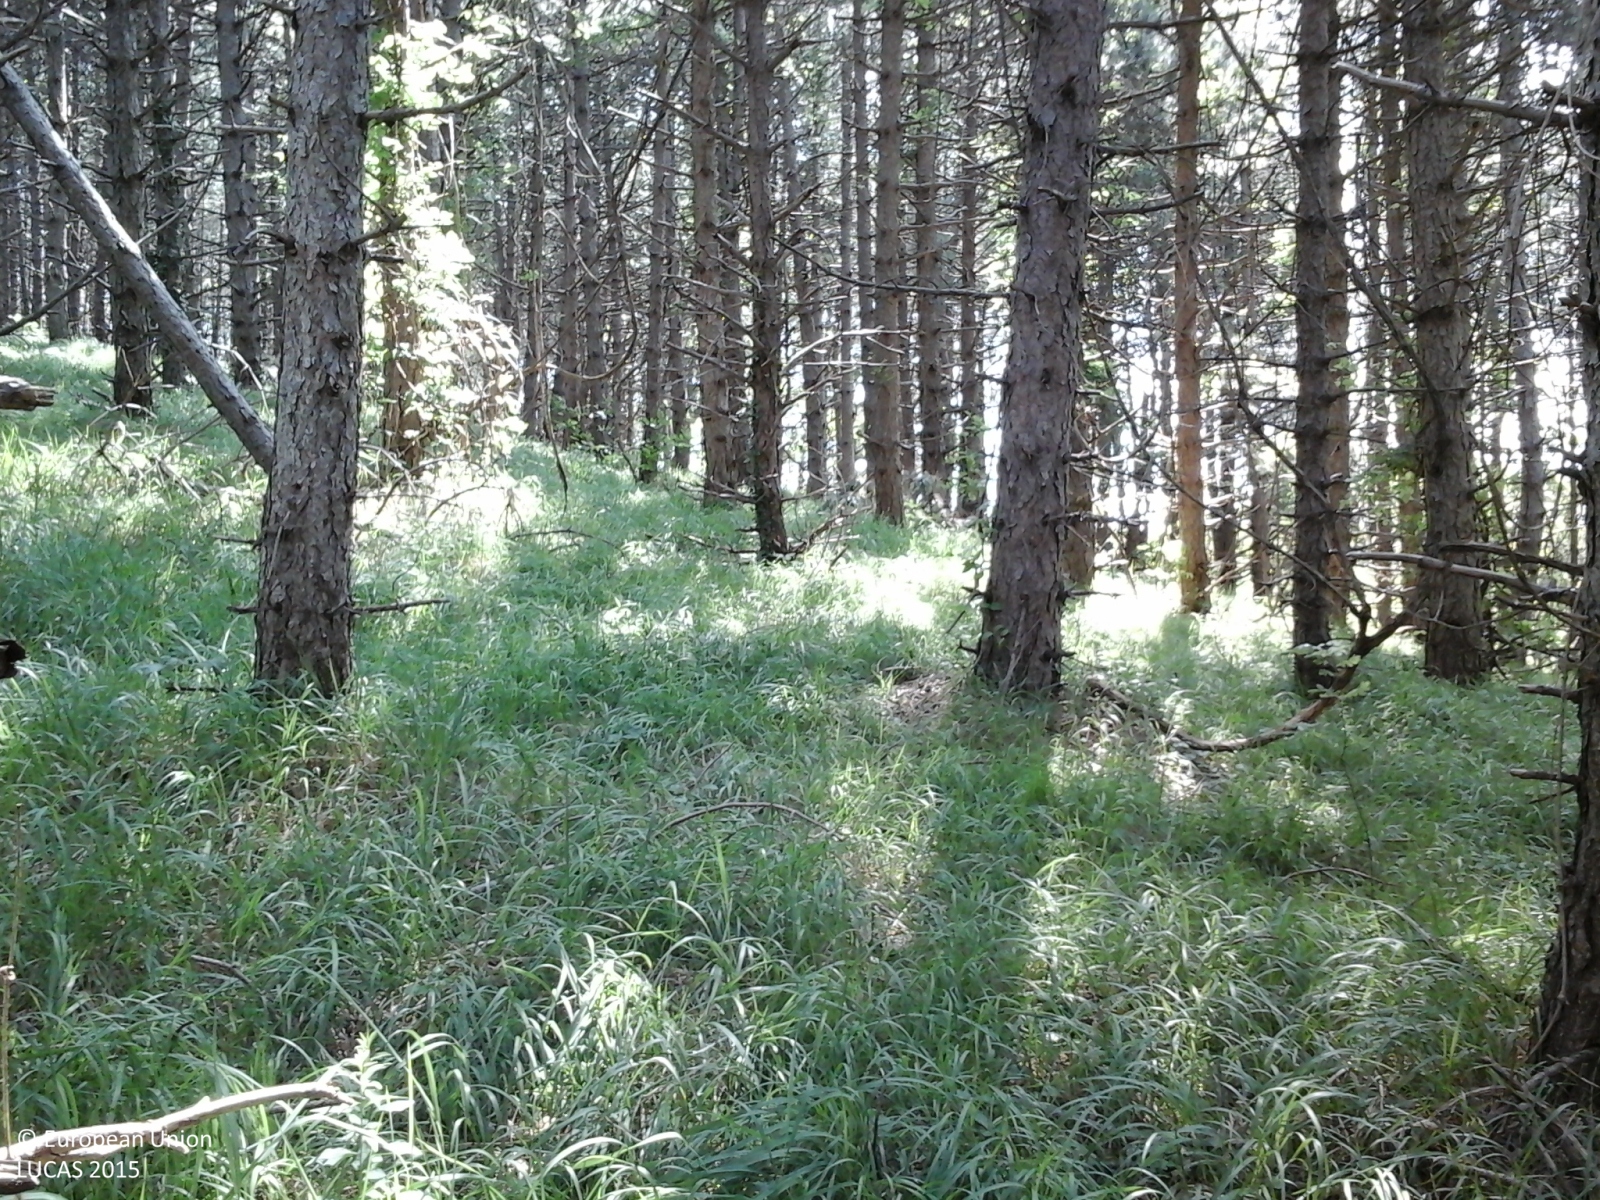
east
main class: Woodland
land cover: Pine dominated coniferous woodland
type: hemiboreal forest and nemoral coniferous forest and mixed broadleaved-coniferous forest
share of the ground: > 75 %
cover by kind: coniferous forest trees 100 %
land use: Forestry
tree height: > 5 m
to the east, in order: Pine dominated coniferous woodland; Lucerne; Shrubland with sparse tree cover; Electric lines; Paved roads, cycling and walking lanes; Broadleaved woodland
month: June
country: IT
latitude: 44.1392
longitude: 11.6337
